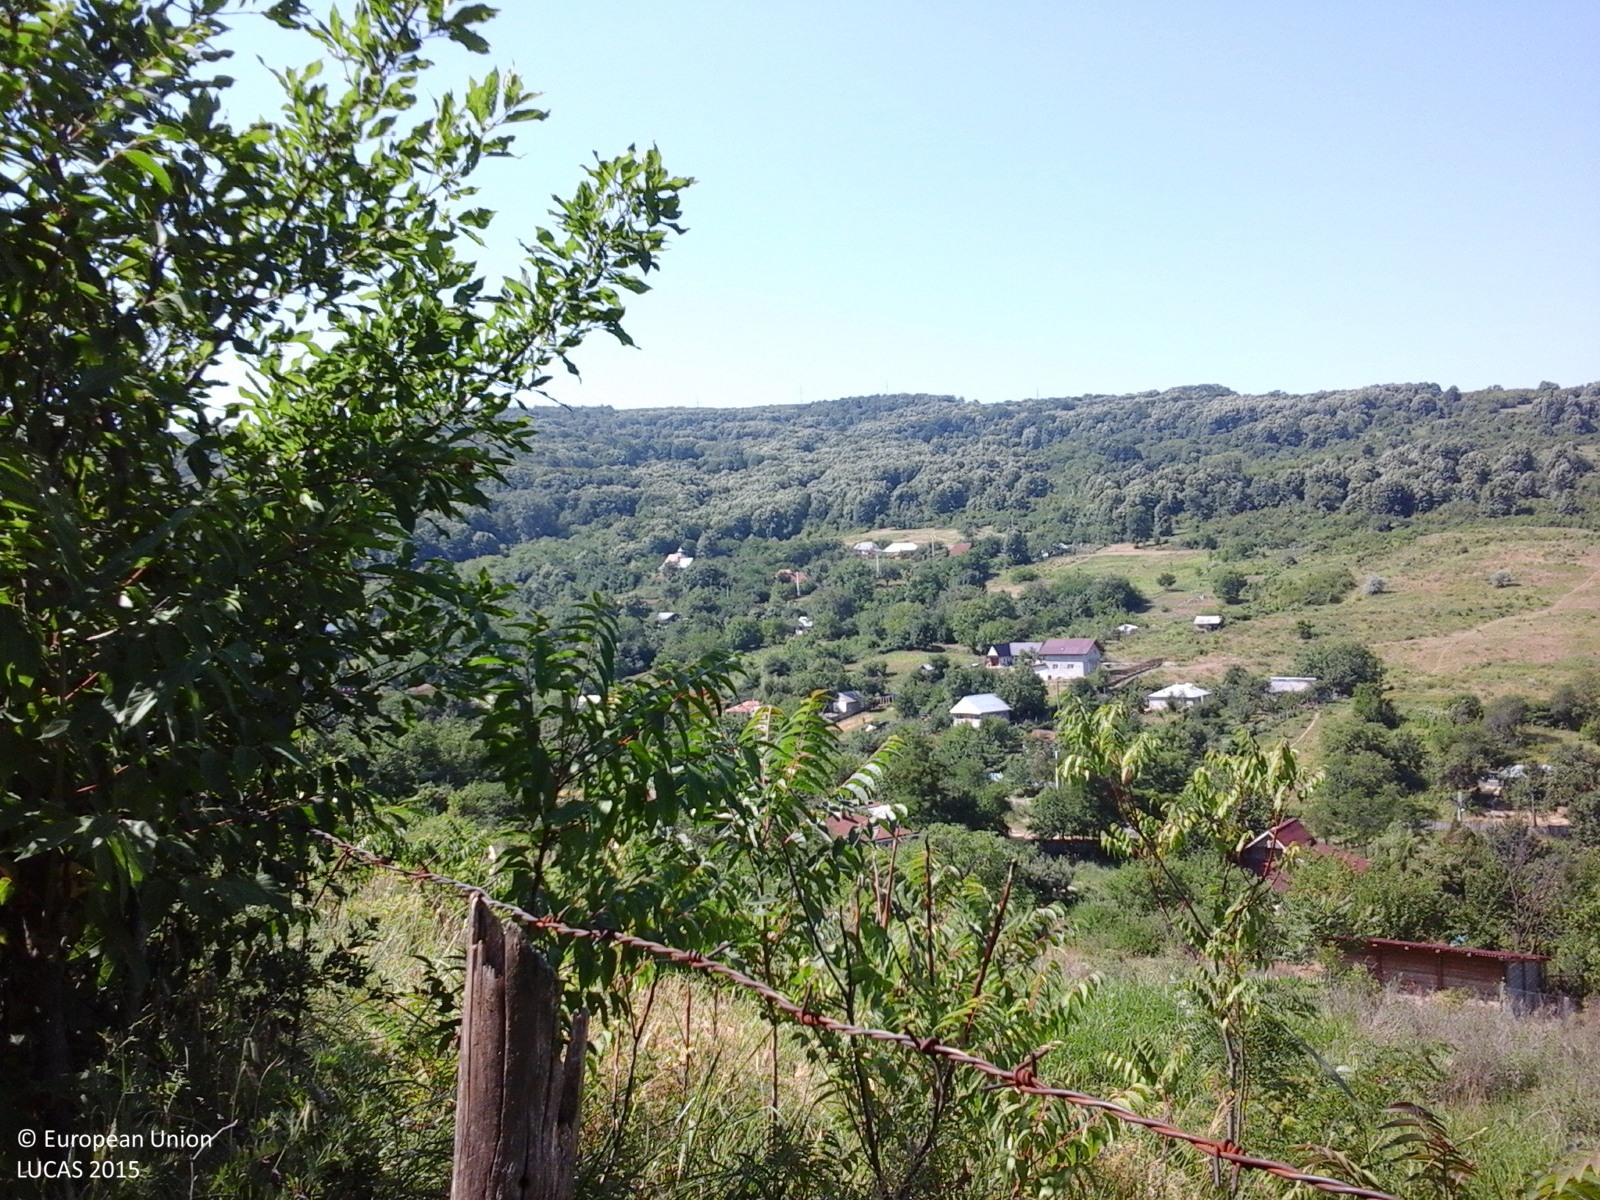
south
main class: Grassland
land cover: Grassland with sparse tree/shrub cover
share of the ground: > 75 %
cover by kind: herbaceous plants 90 %, broadleaved forest trees 5 %, shrubs 5 %
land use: Agriculture (excluding fallow land and kitchen gardens)
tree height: > 5 m
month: June
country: RO
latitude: 47.1311
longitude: 27.6679
